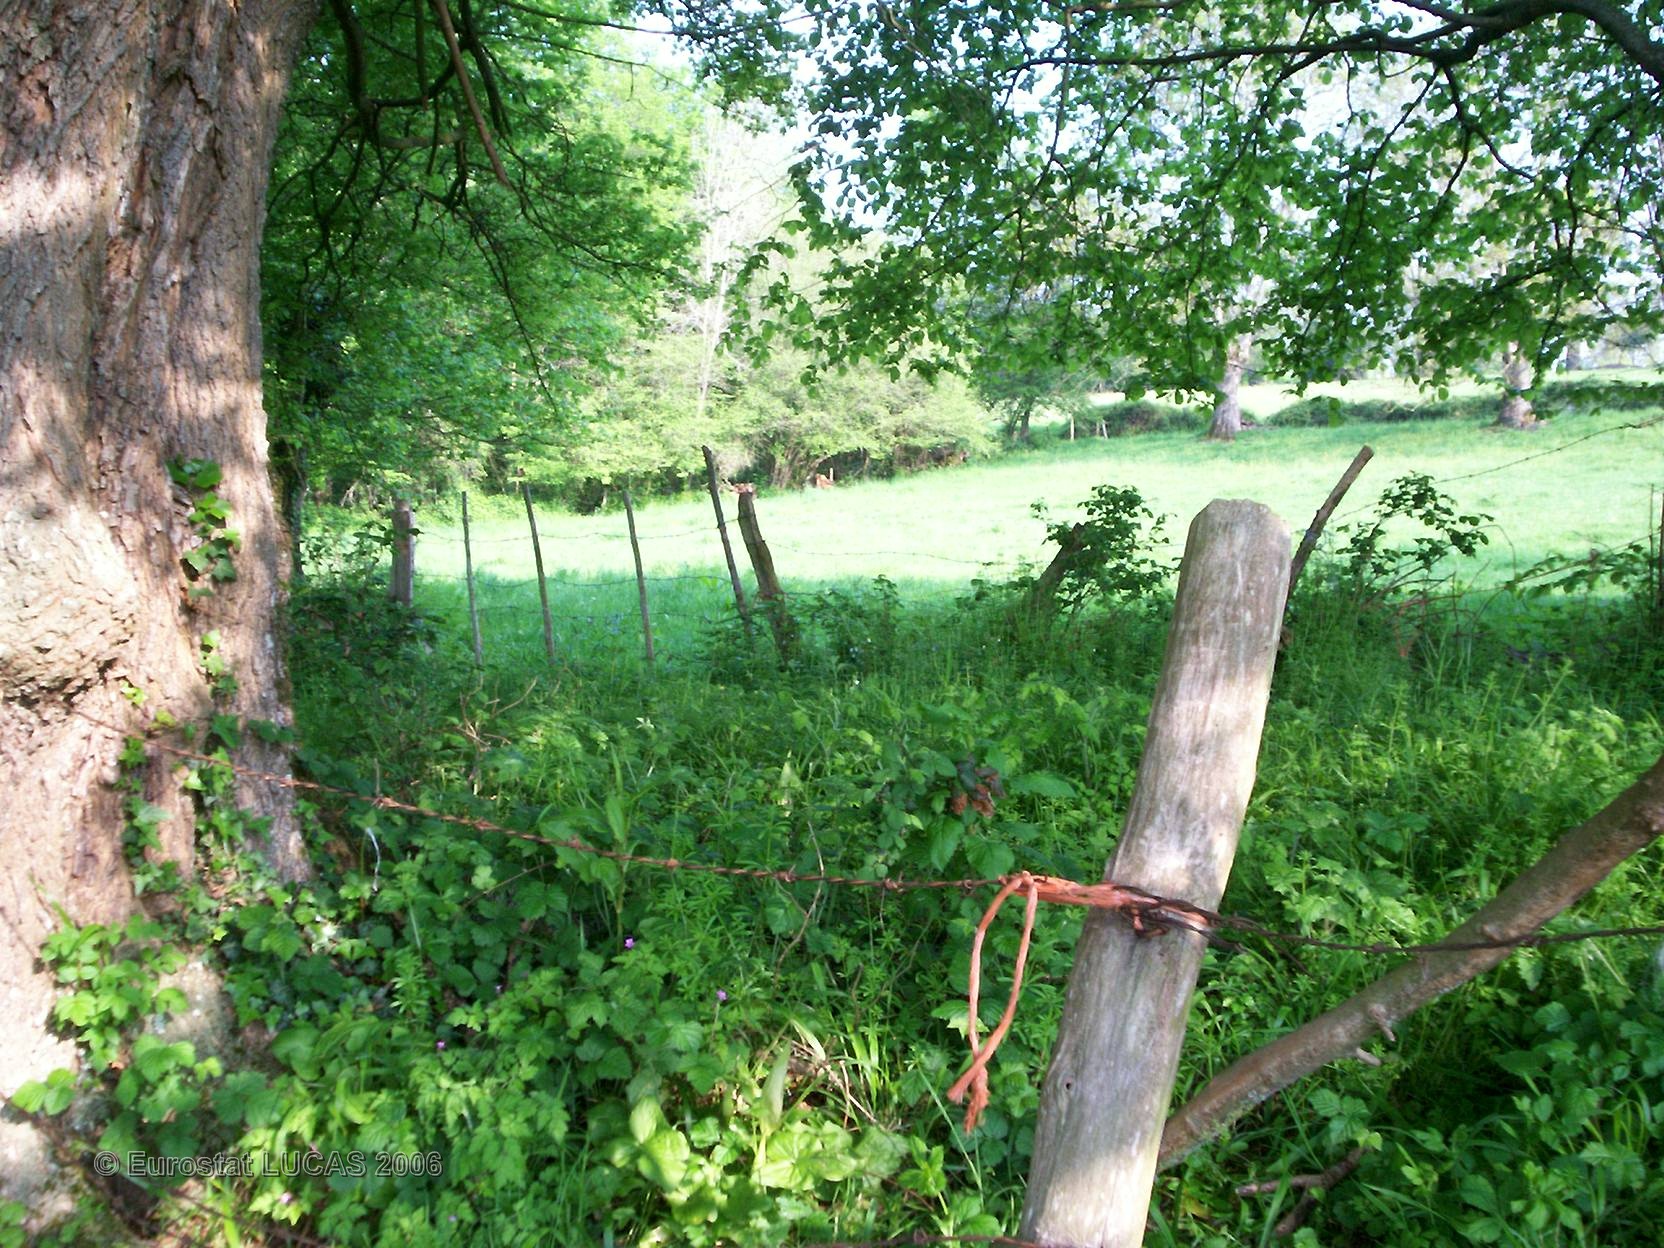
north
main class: Grassland
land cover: Grassland without tree/shrub cover
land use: Agriculture (excluding fallow land and kitchen gardens)
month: May
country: FR
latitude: 48.5903
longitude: 0.2791
